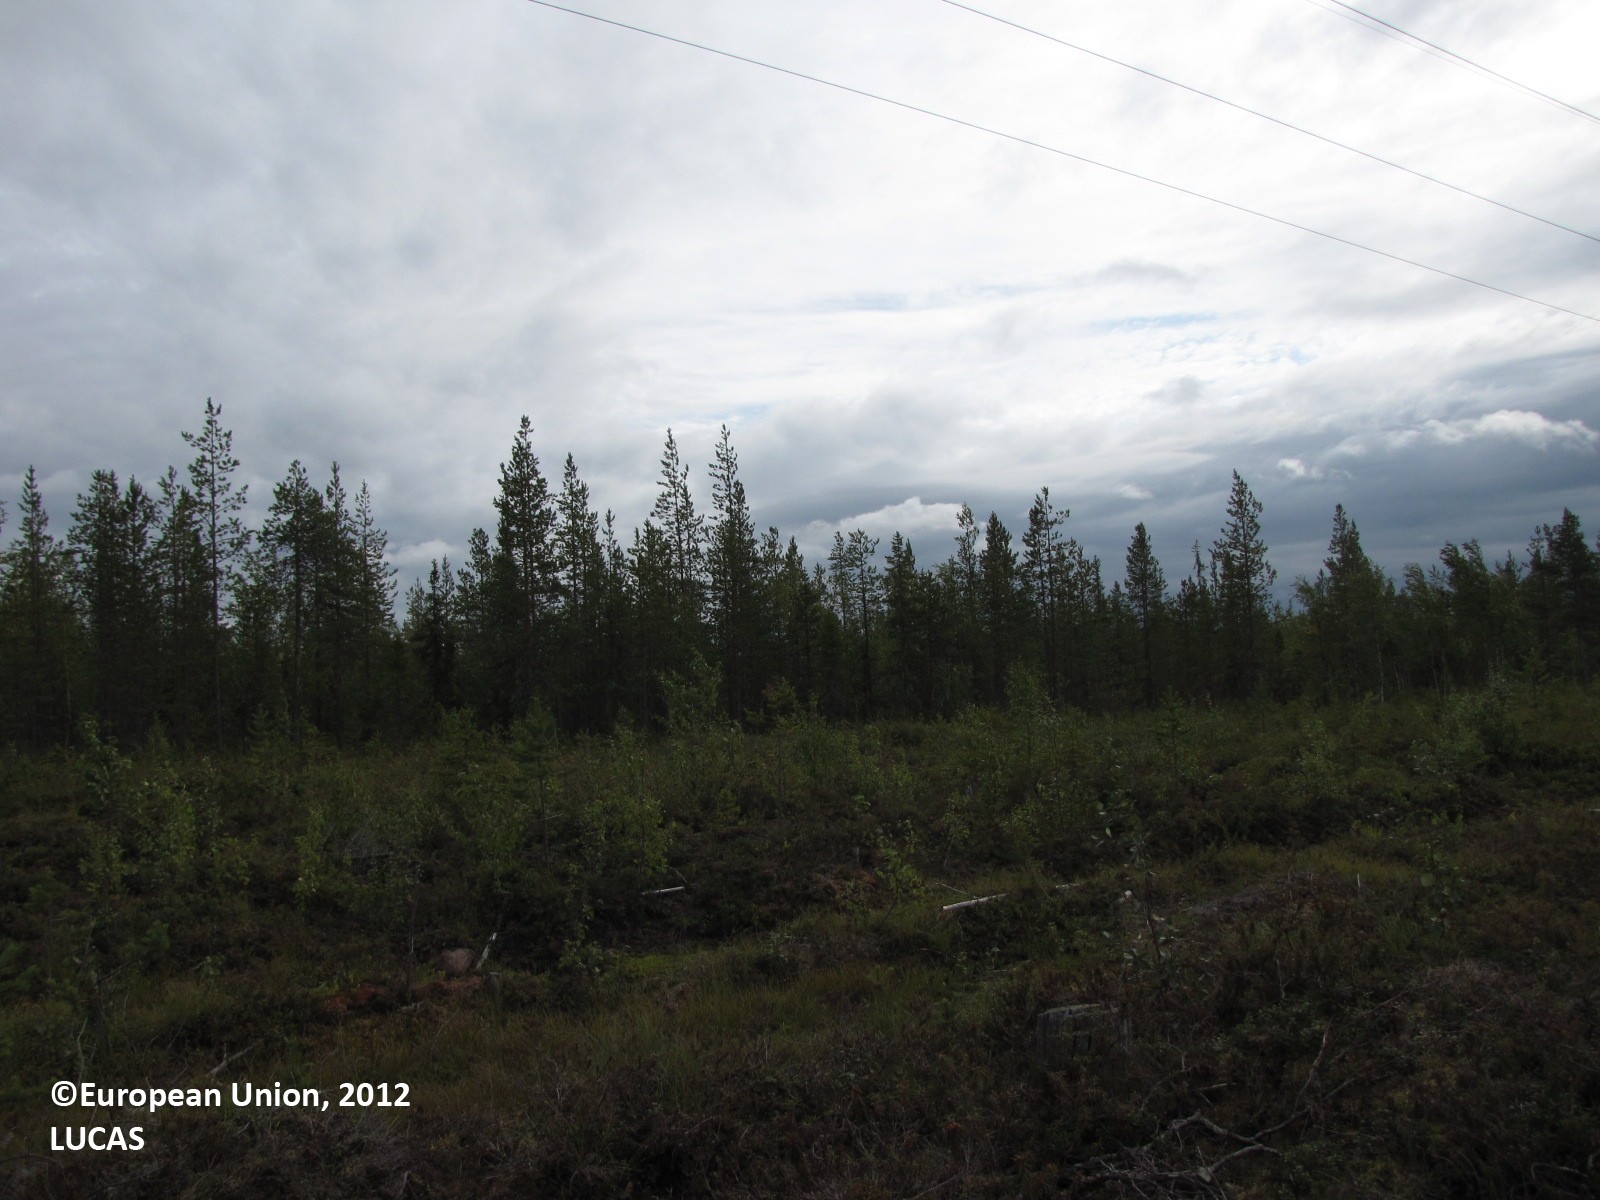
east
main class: Shrubland
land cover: Shrubland with sparse tree cover
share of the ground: > 75 %
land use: Energy production
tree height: < 5 m
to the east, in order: Shrubland with sparse tree cover; Electric lines; Shrubland with sparse tree cover; Pine dominated mixed woodland; Pine dominated coniferous woodland; Shrubland with sparse tree cover
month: August
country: FI
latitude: 67.1107
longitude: 25.0917
